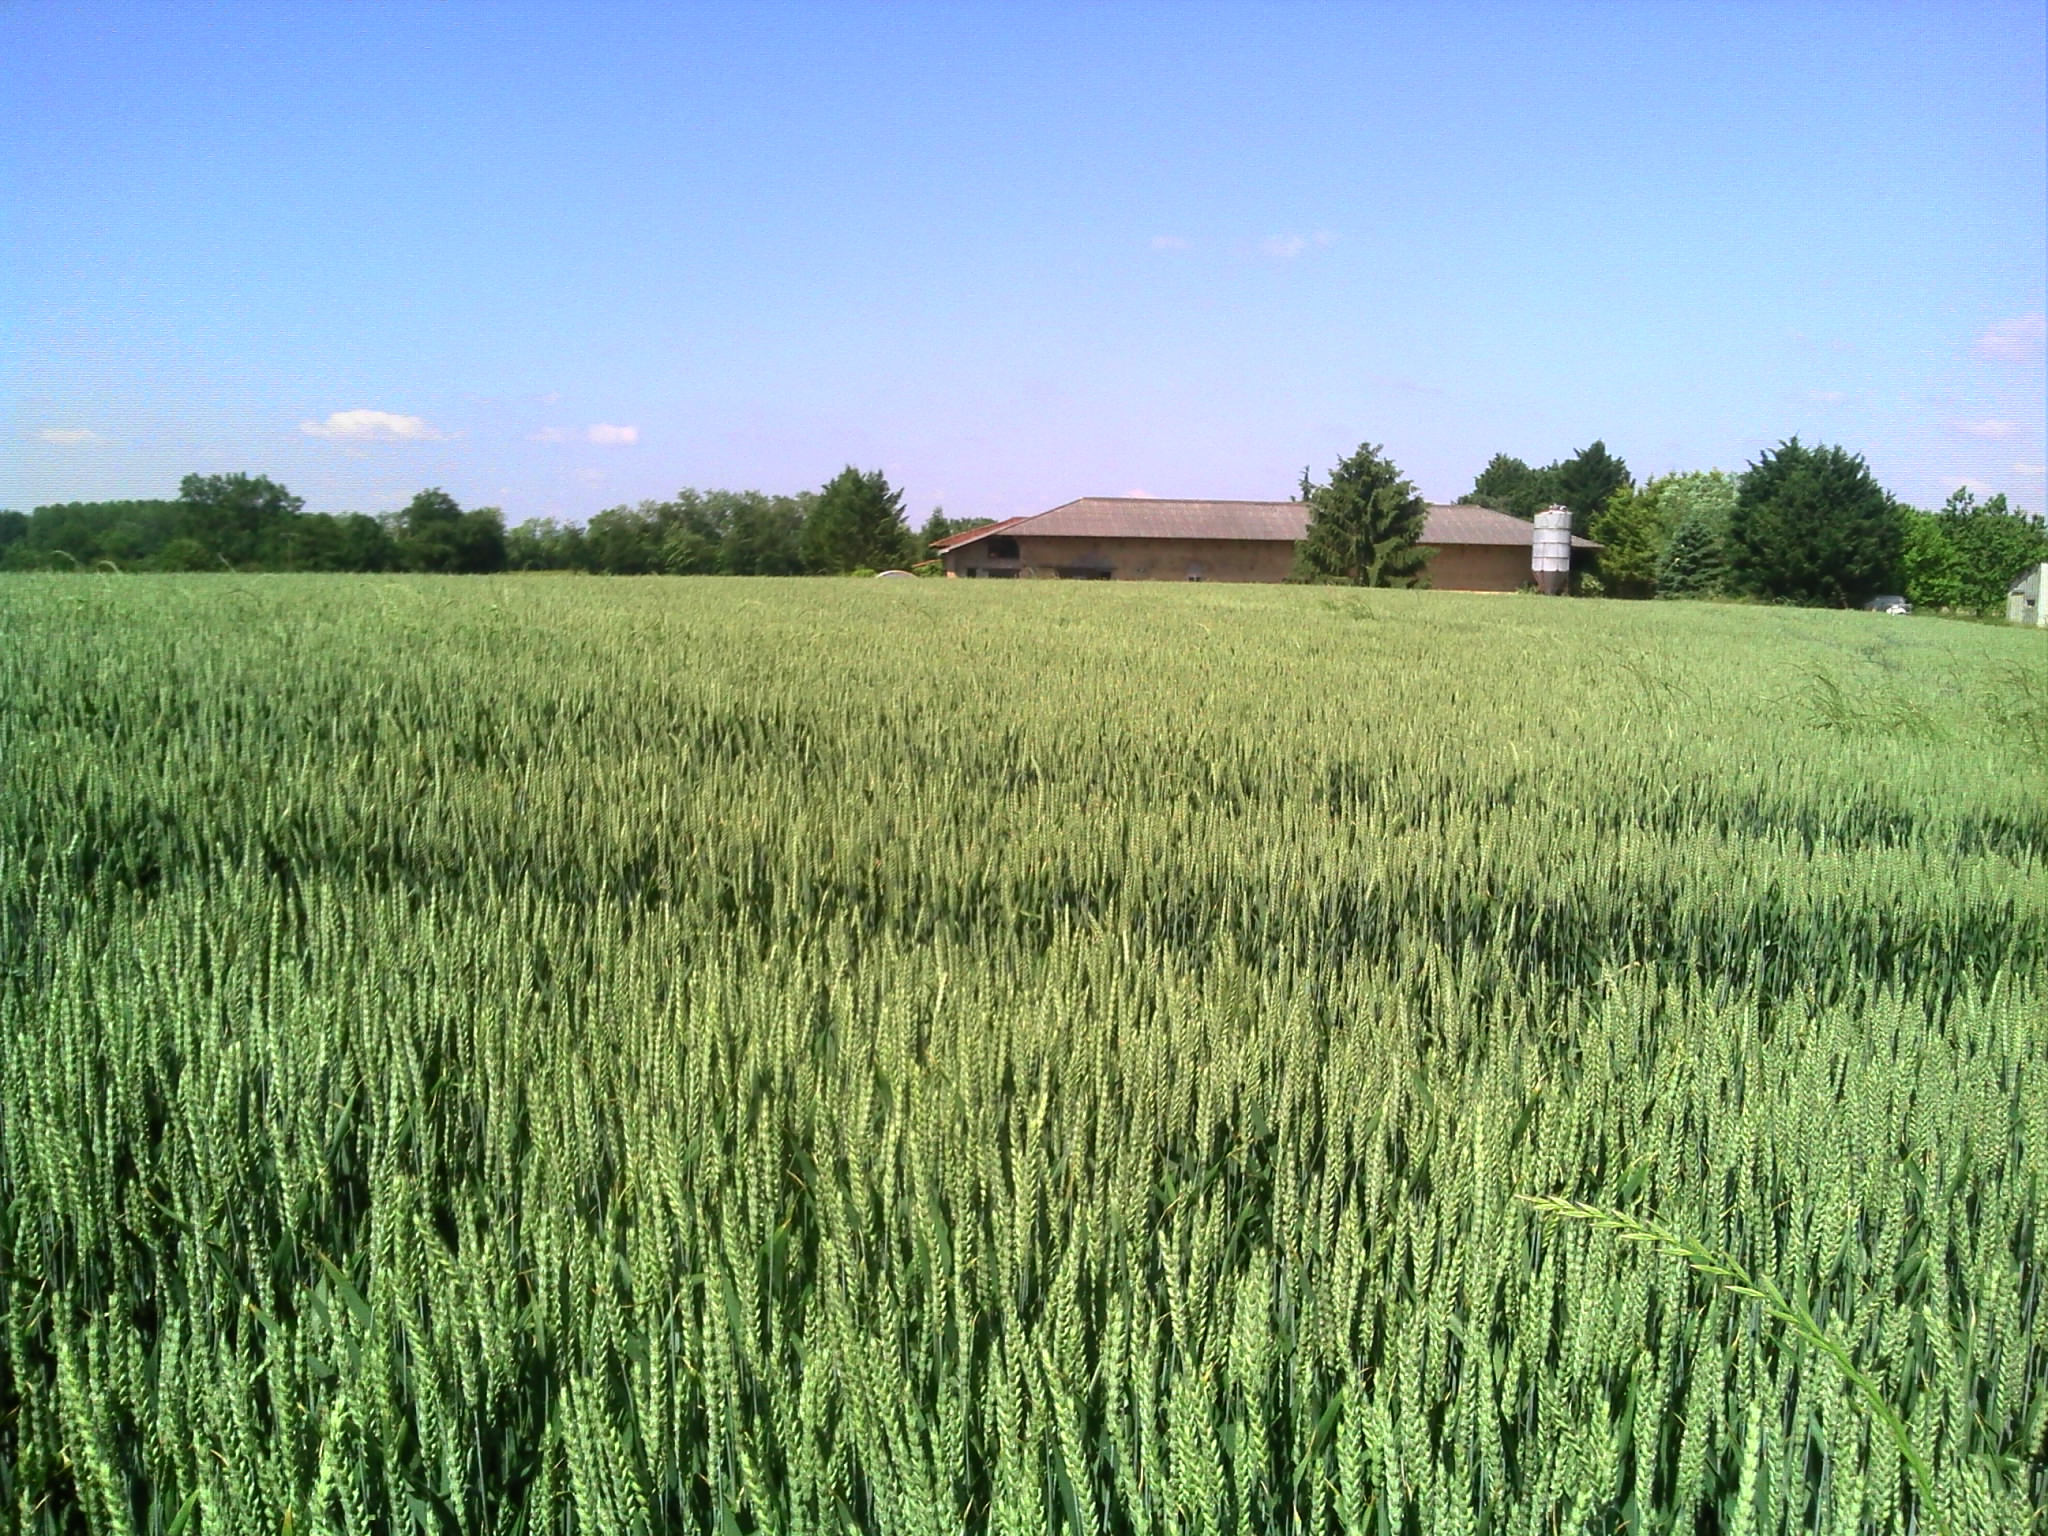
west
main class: Cropland
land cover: Common wheat
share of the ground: > 75 %
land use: Agriculture (excluding fallow land and kitchen gardens)
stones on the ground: < 10 %
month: May
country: FR
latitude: 46.5259
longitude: 5.0613
